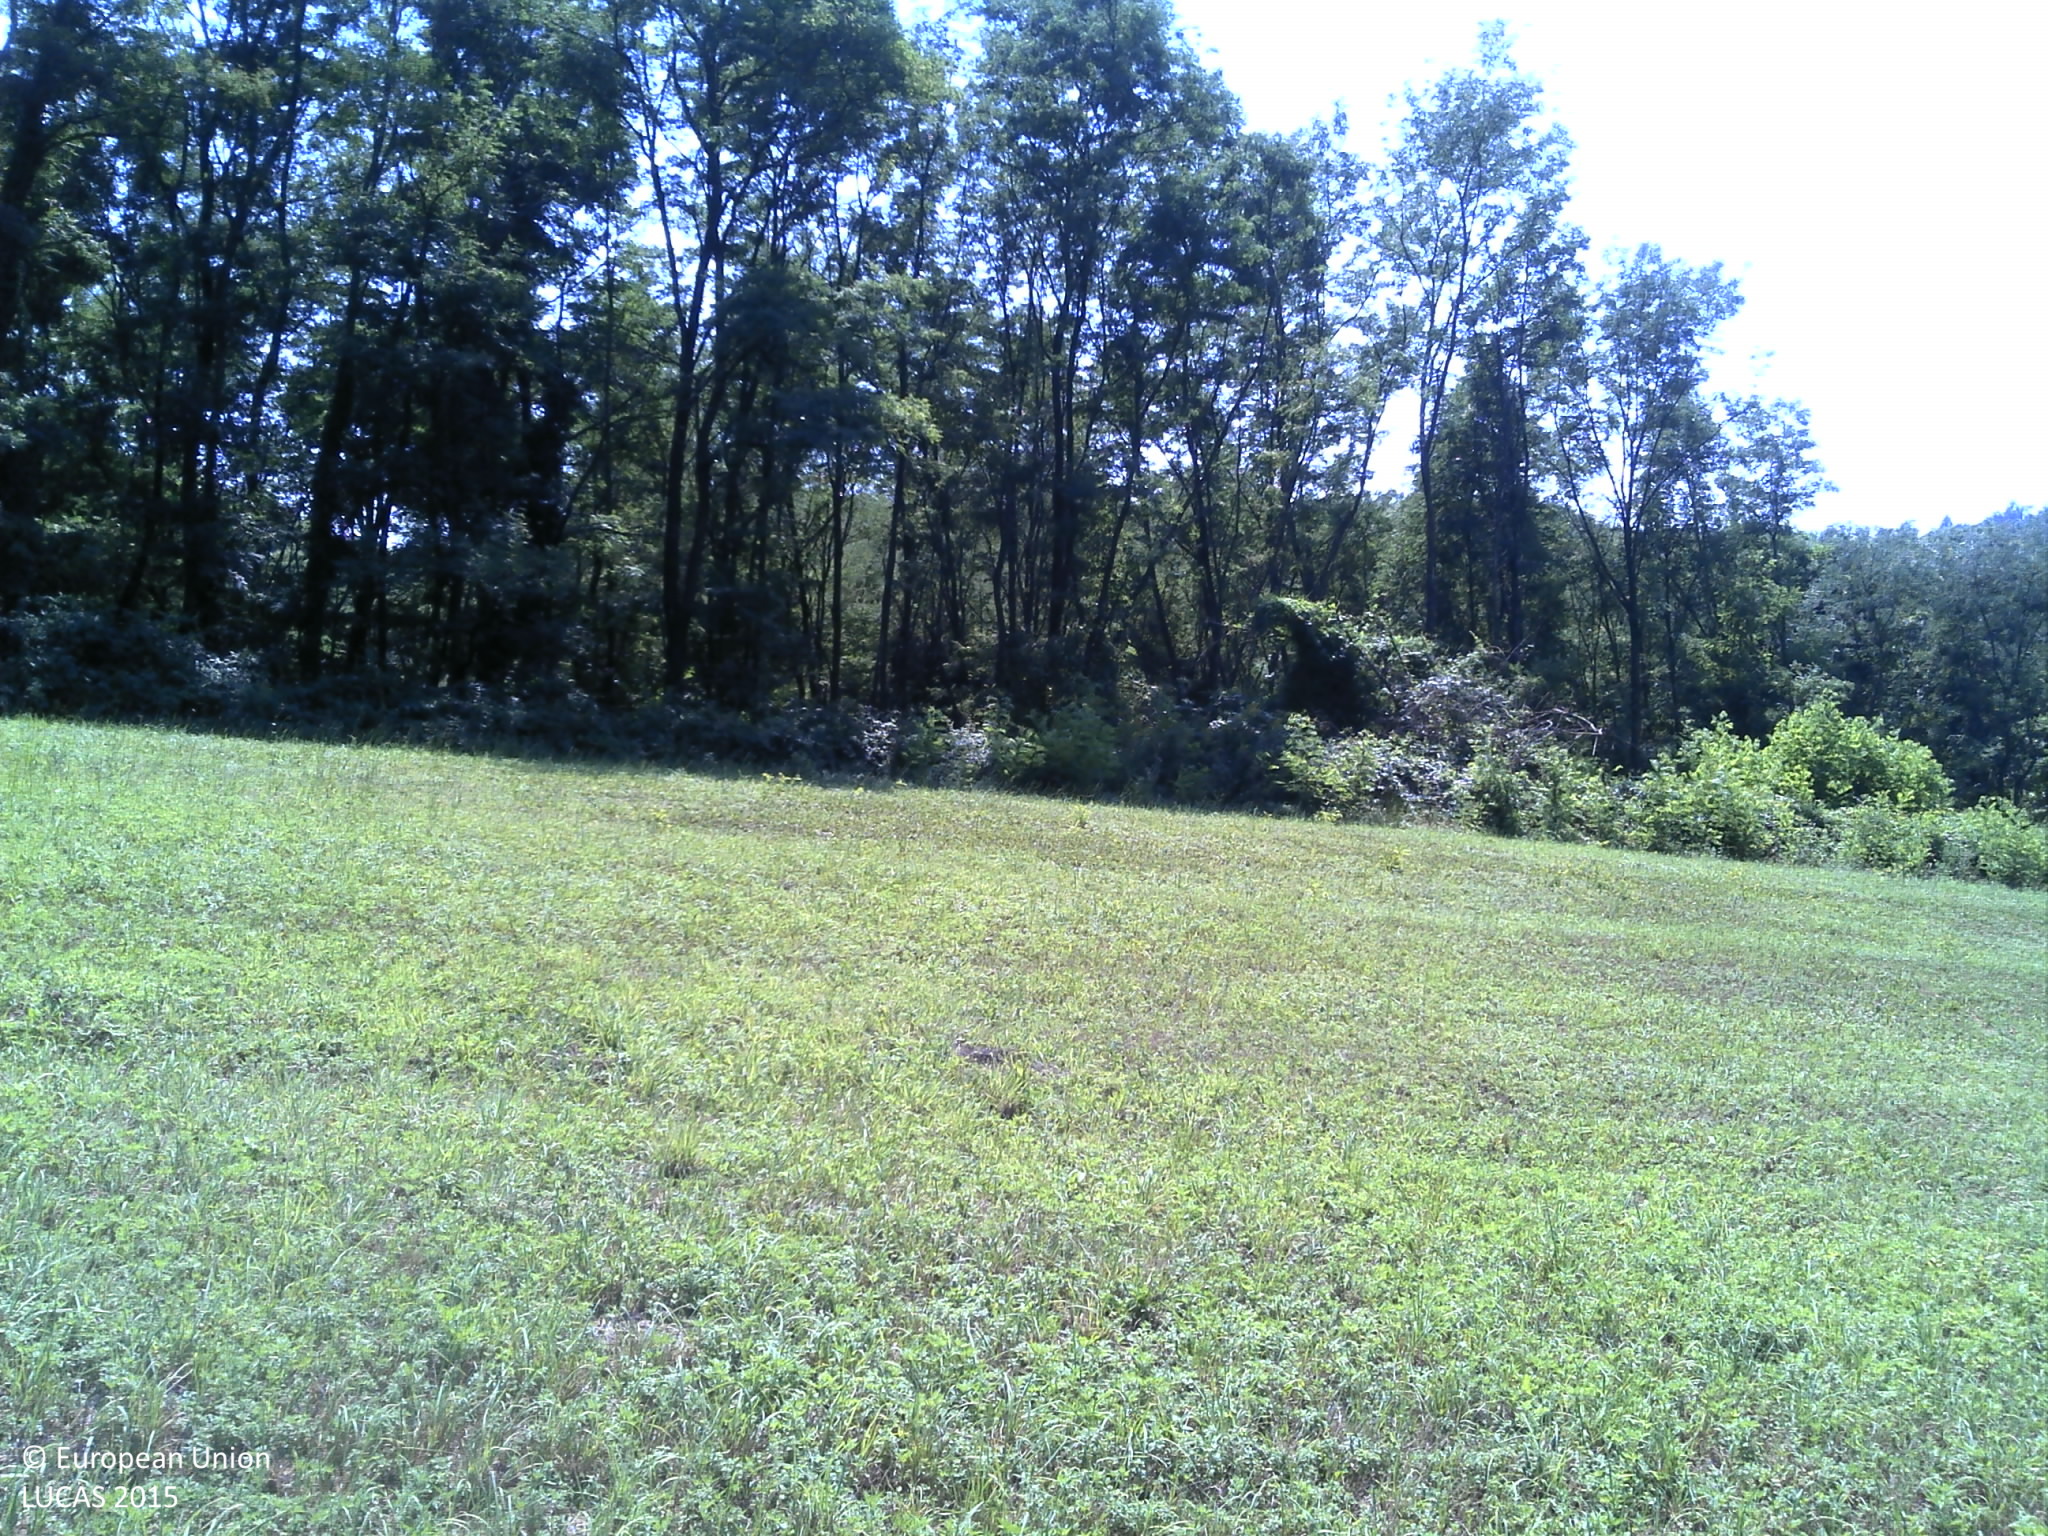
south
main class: Grassland
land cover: Spontaneously vegetated surfaces
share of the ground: > 75 %
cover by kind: herbaceous plants 100 %
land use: Semi-natural and natural areas not in use
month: August
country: HR
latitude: 46.0991
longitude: 16.7921
